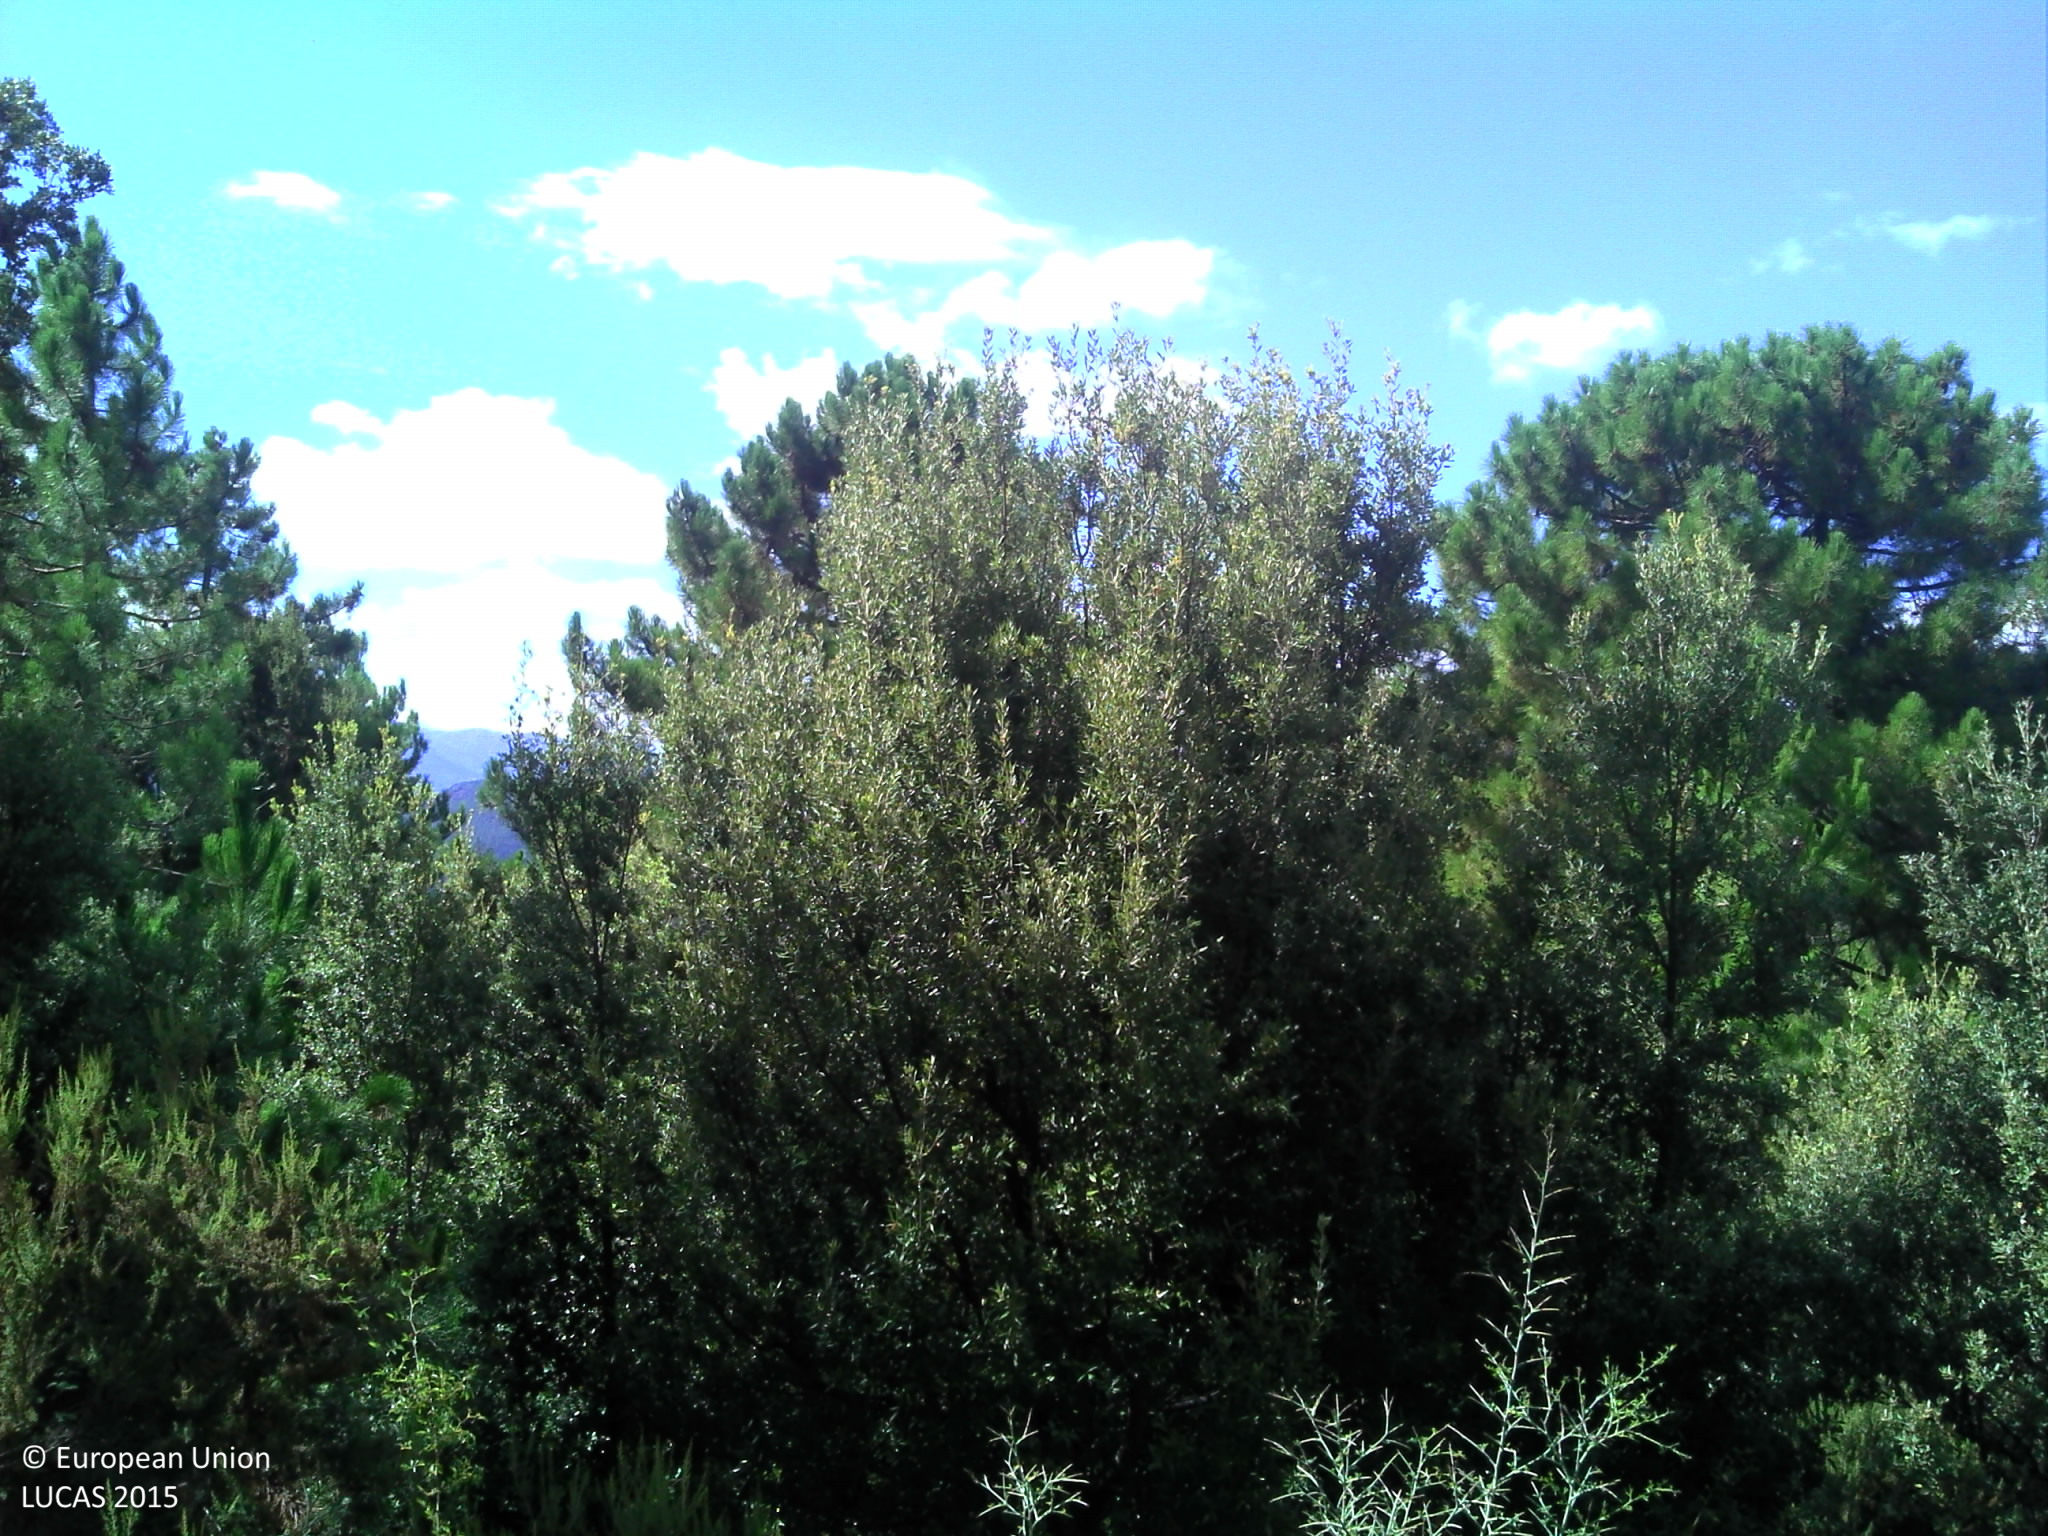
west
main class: Shrubland
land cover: Shrubland with sparse tree cover
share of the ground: > 75 %
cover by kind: shrubs 95 %, broadleaved forest trees 5 %
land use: Semi-natural and natural areas not in use
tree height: < 5 m
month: September
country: FR
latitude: 42.4347
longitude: 9.2853
